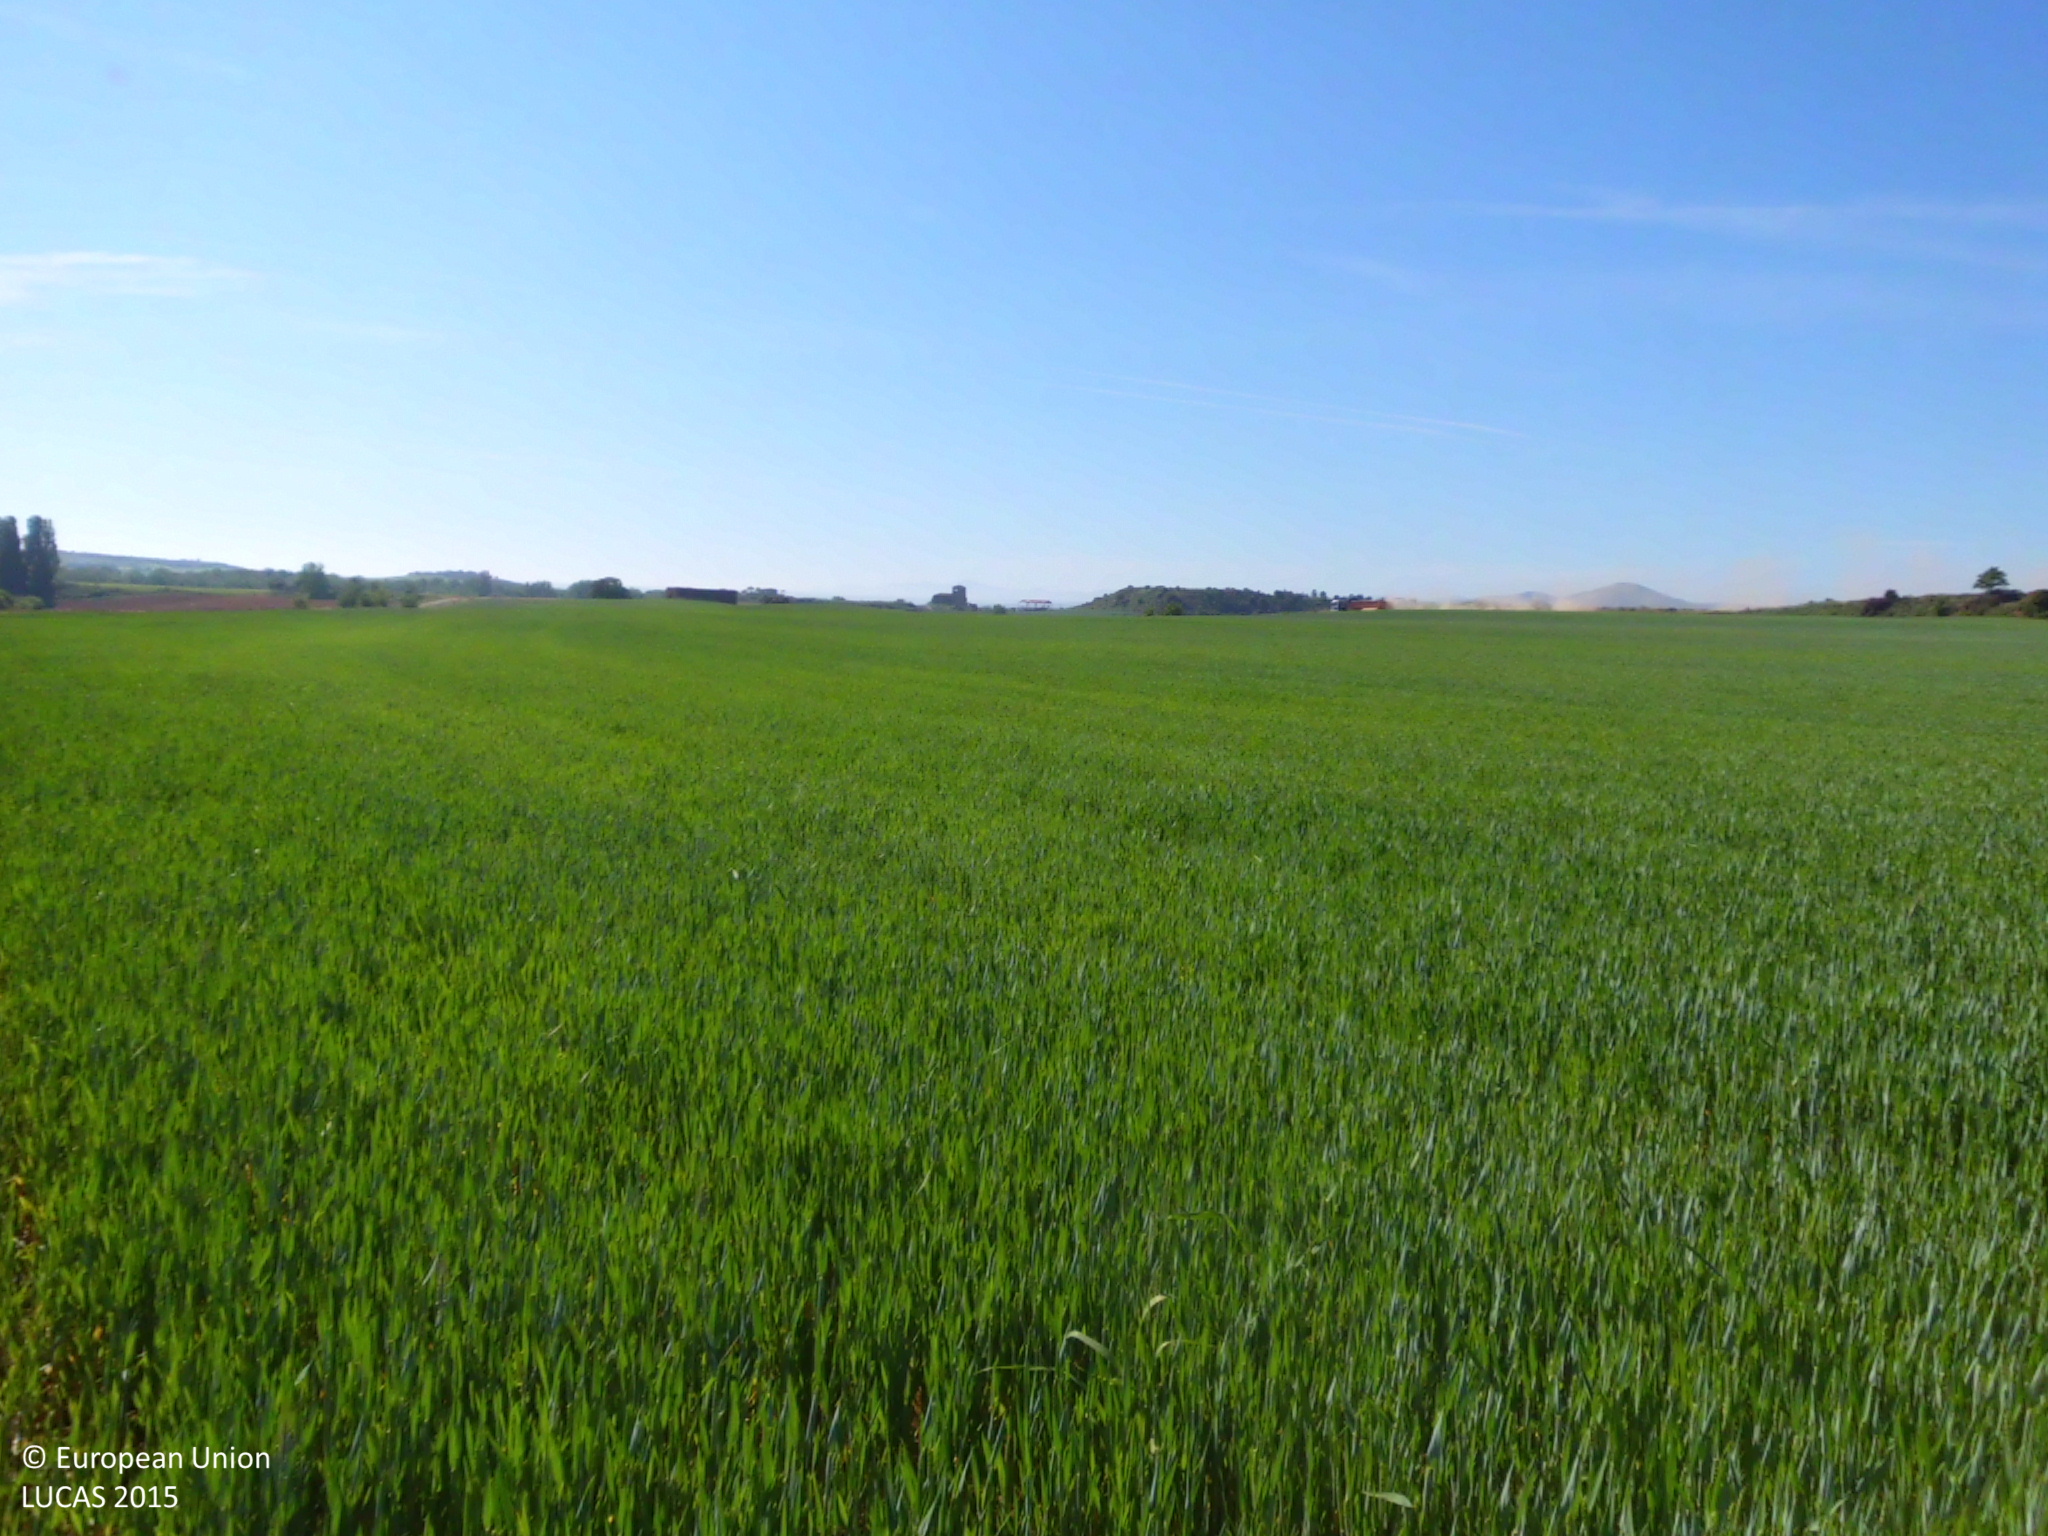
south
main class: Cropland
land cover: Common wheat
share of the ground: > 75 %
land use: Agriculture (excluding fallow land and kitchen gardens)
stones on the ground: 25 - 50 %
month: May
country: ES
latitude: 42.6671
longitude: -3.4447
